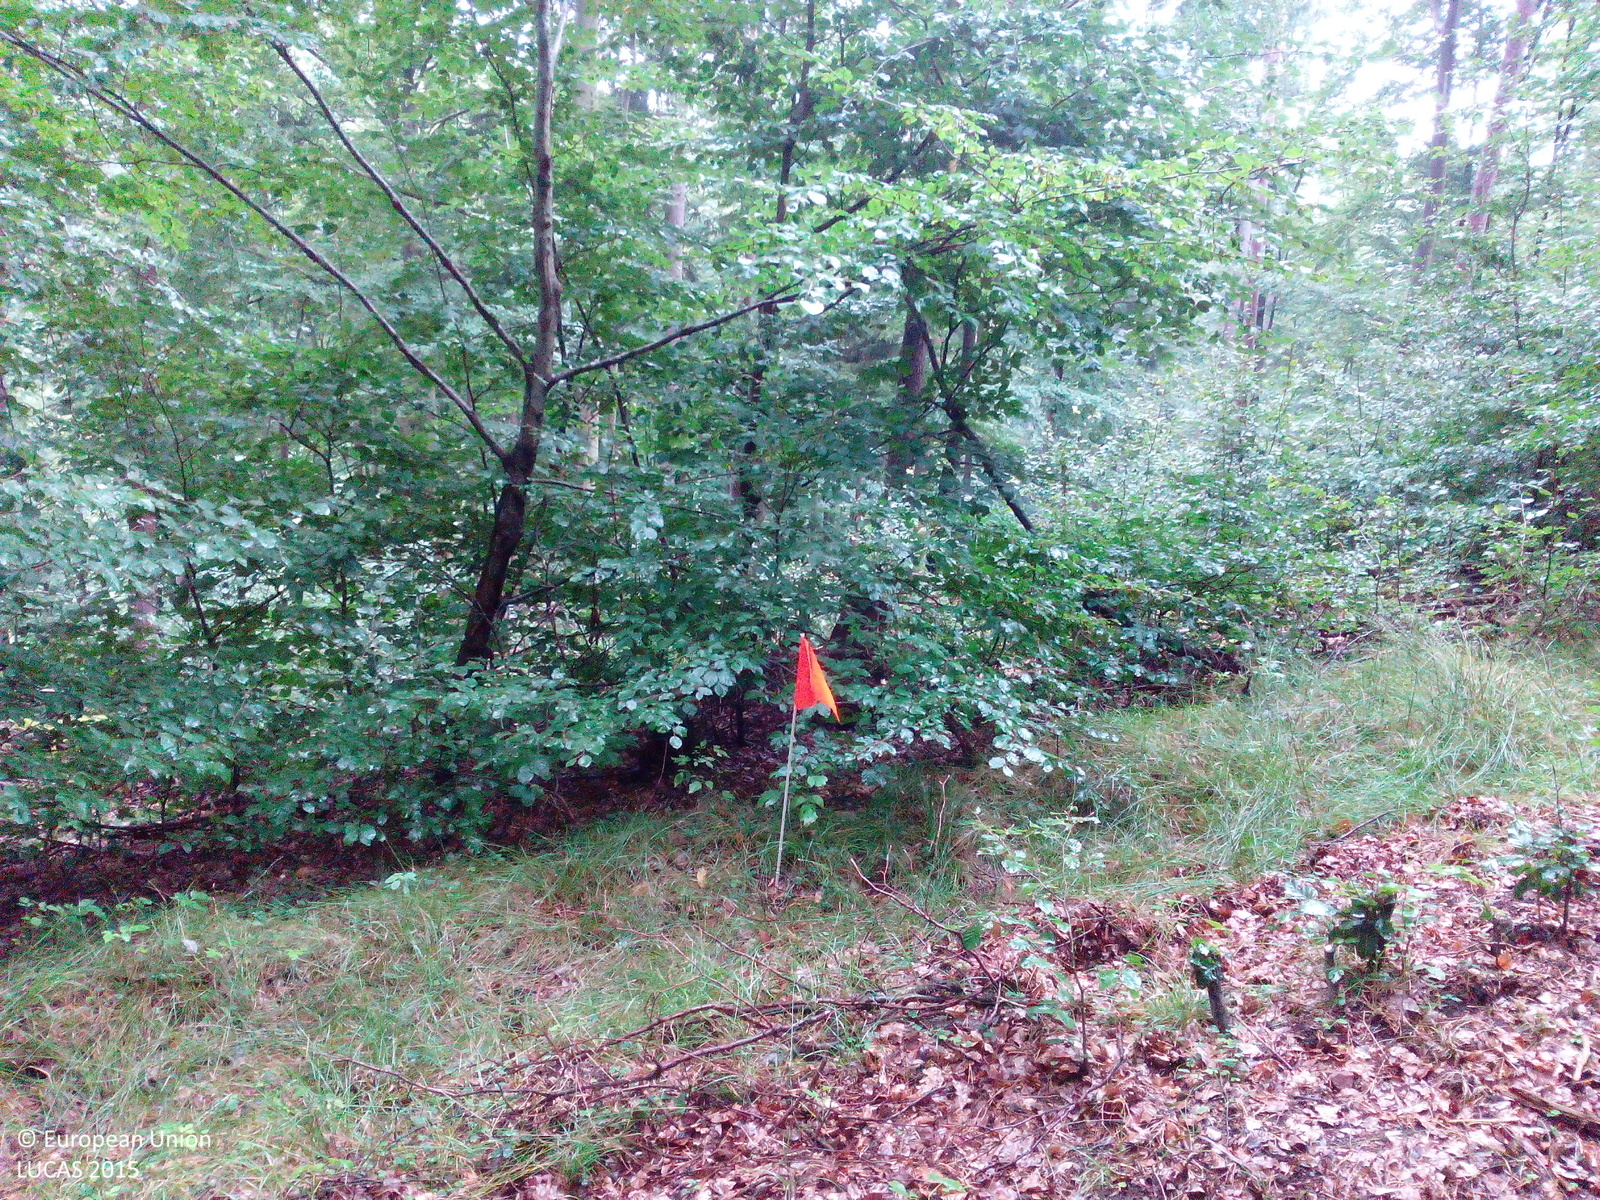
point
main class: Woodland
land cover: Pine dominated mixed woodland
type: hemiboreal forest and nemoral coniferous forest and mixed broadleaved-coniferous forest
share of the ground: > 75 %
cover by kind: broadleaved forest trees 65 %, coniferous forest trees 25 %, herbaceous plants 5 %, unconsolidated bare surface 5 %
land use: Forestry
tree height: > 5 m
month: September
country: DE
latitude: 49.9309
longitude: 9.4012
